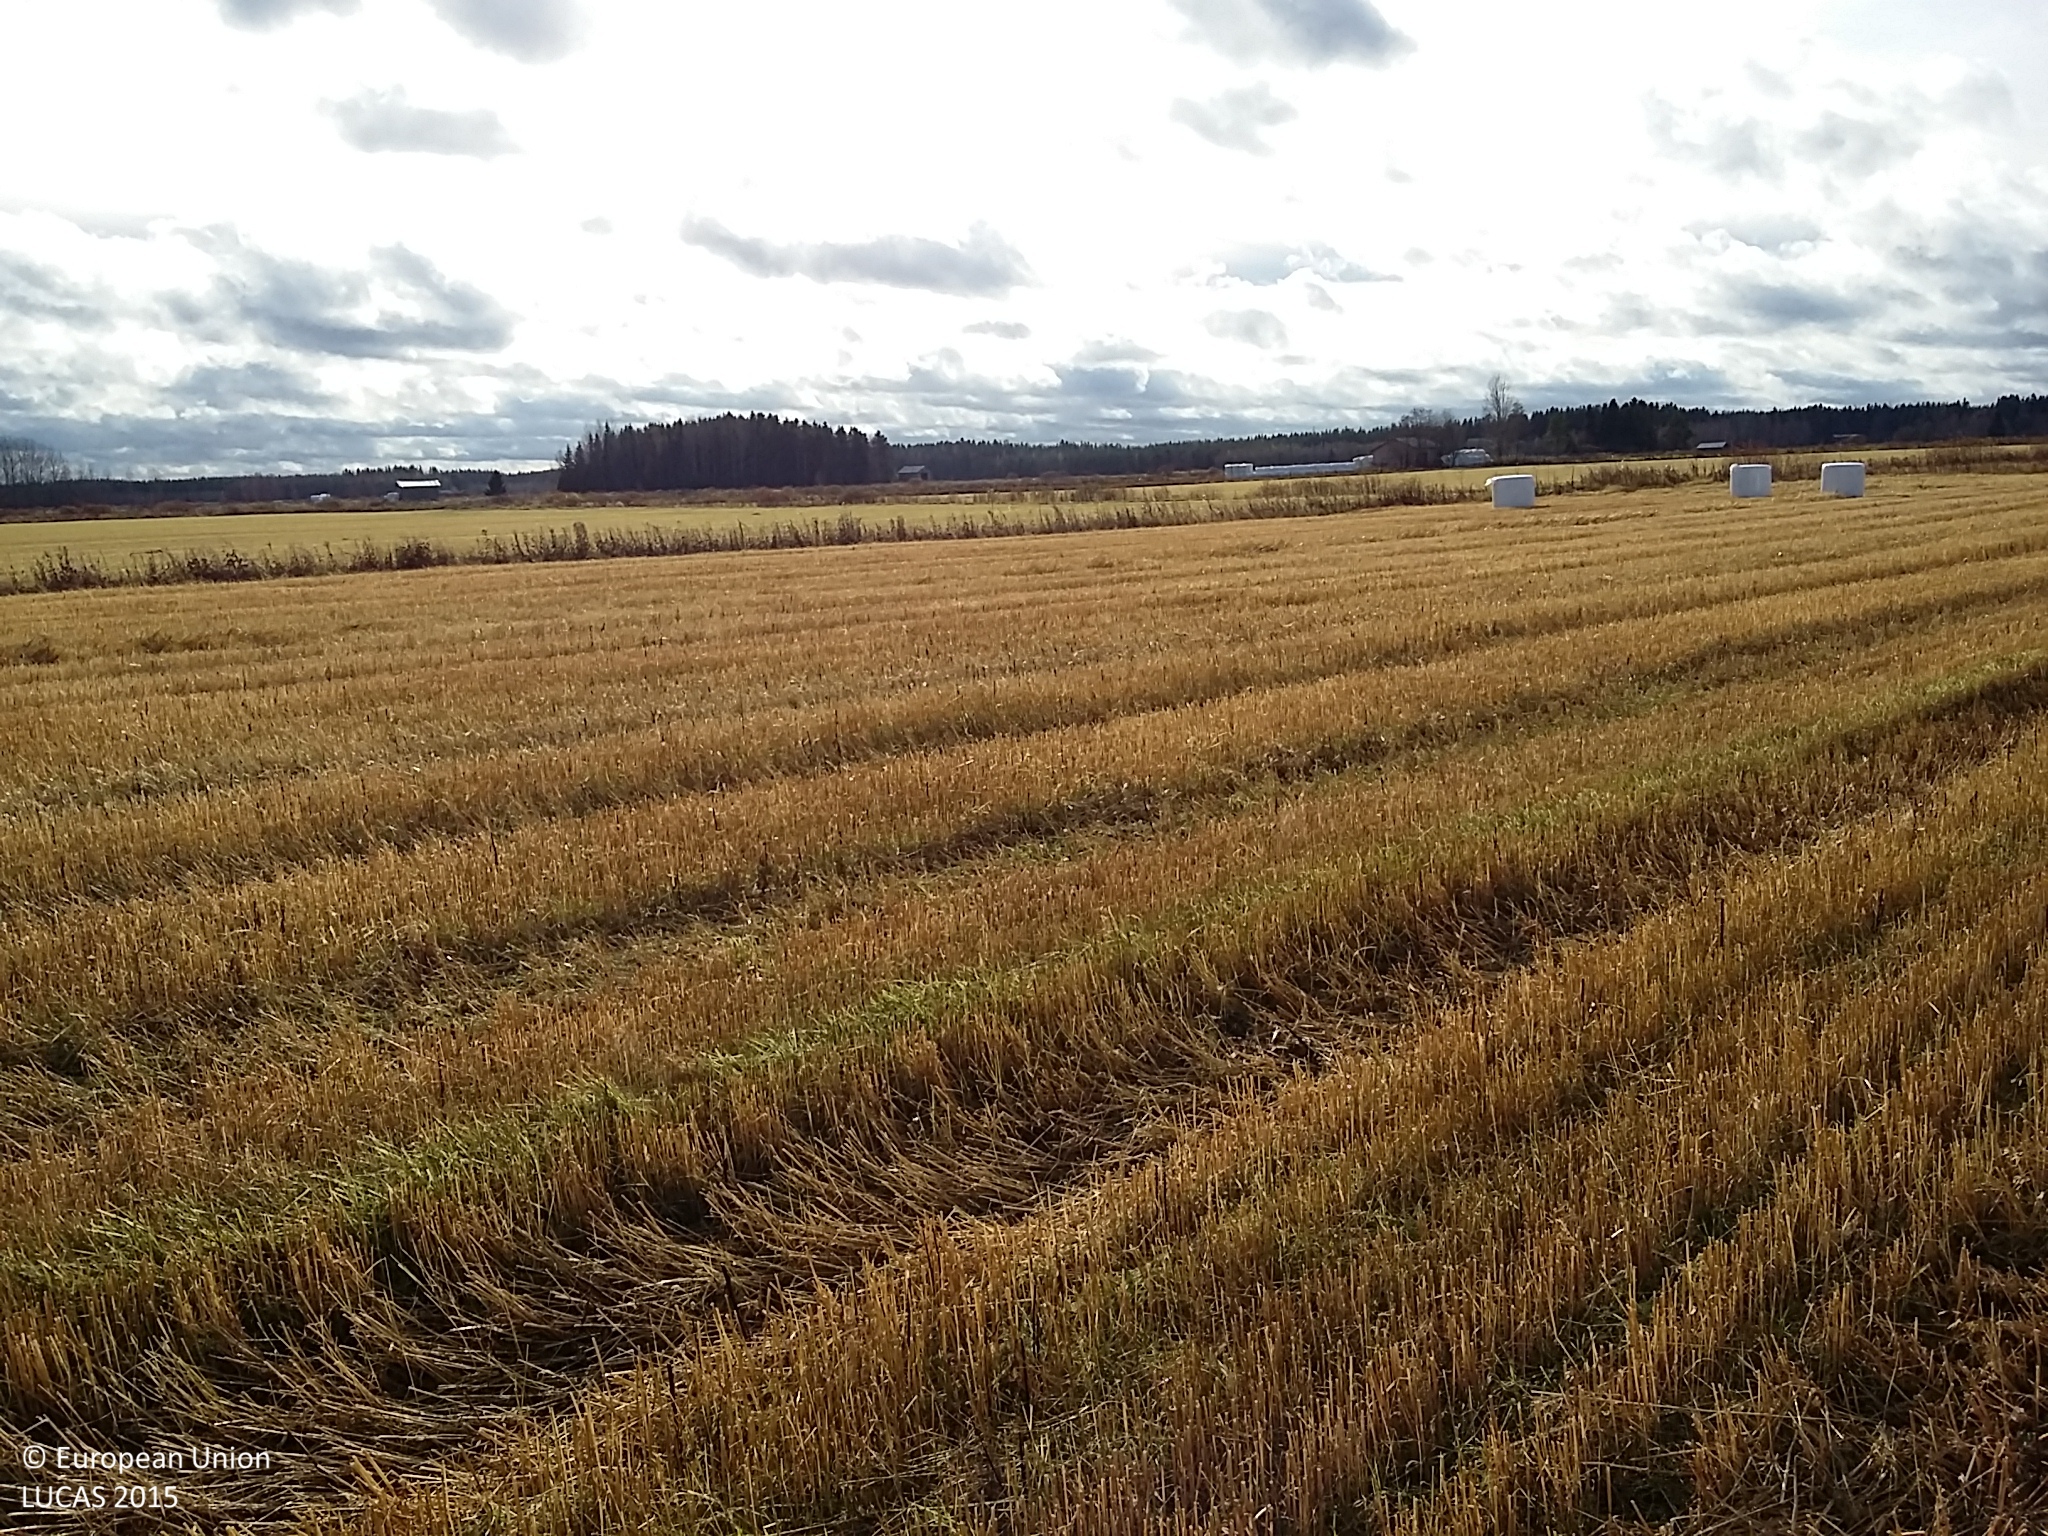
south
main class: Cropland
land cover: Oats
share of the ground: > 75 %
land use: Agriculture (excluding fallow land and kitchen gardens)
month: October
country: FI
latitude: 63.8853
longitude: 24.9704
